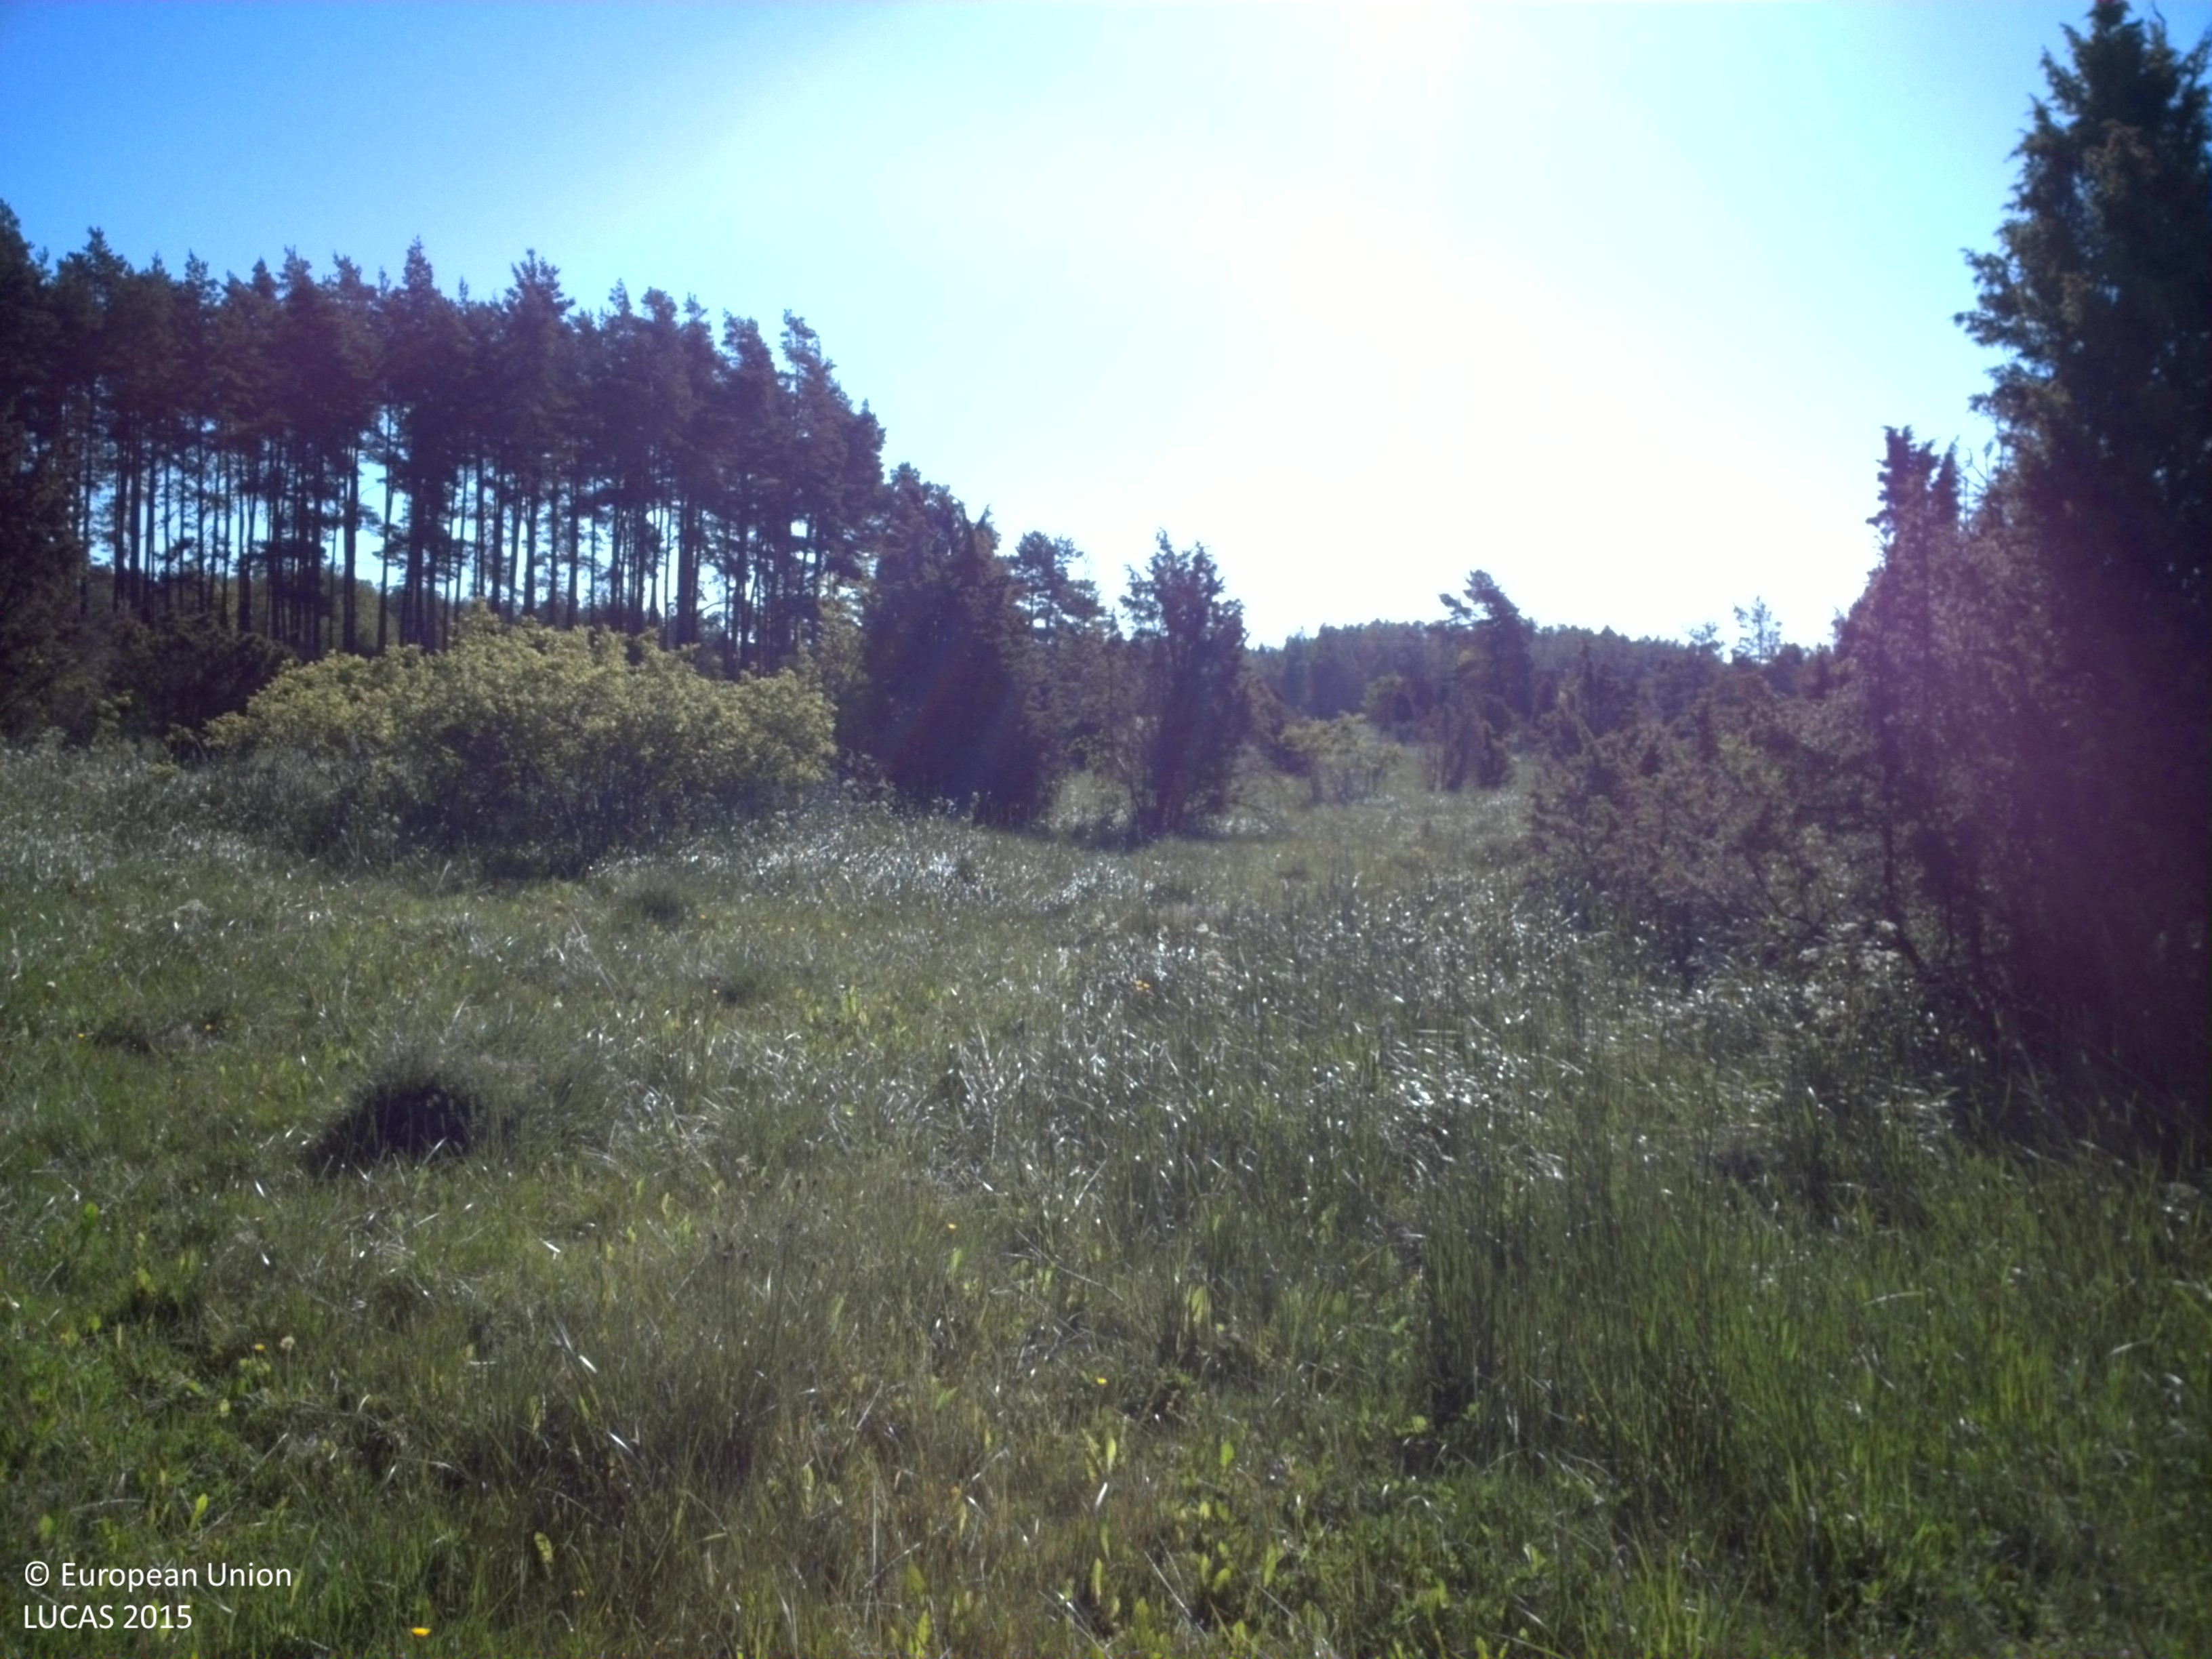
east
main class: Grassland
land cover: Grassland with sparse tree/shrub cover
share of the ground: > 75 %
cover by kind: herbaceous plants 90 %, coniferous forest trees 5 %, shrubs 5 %
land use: Agriculture (excluding fallow land and kitchen gardens)
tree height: < 5 m
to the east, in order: Grassland with sparse tree/shrub cover; Ditches and canals; Grassland with sparse tree/shrub cover; Fences; Ditches and canals; Clovers
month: June
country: SE
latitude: 58.4385
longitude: 15.7673
